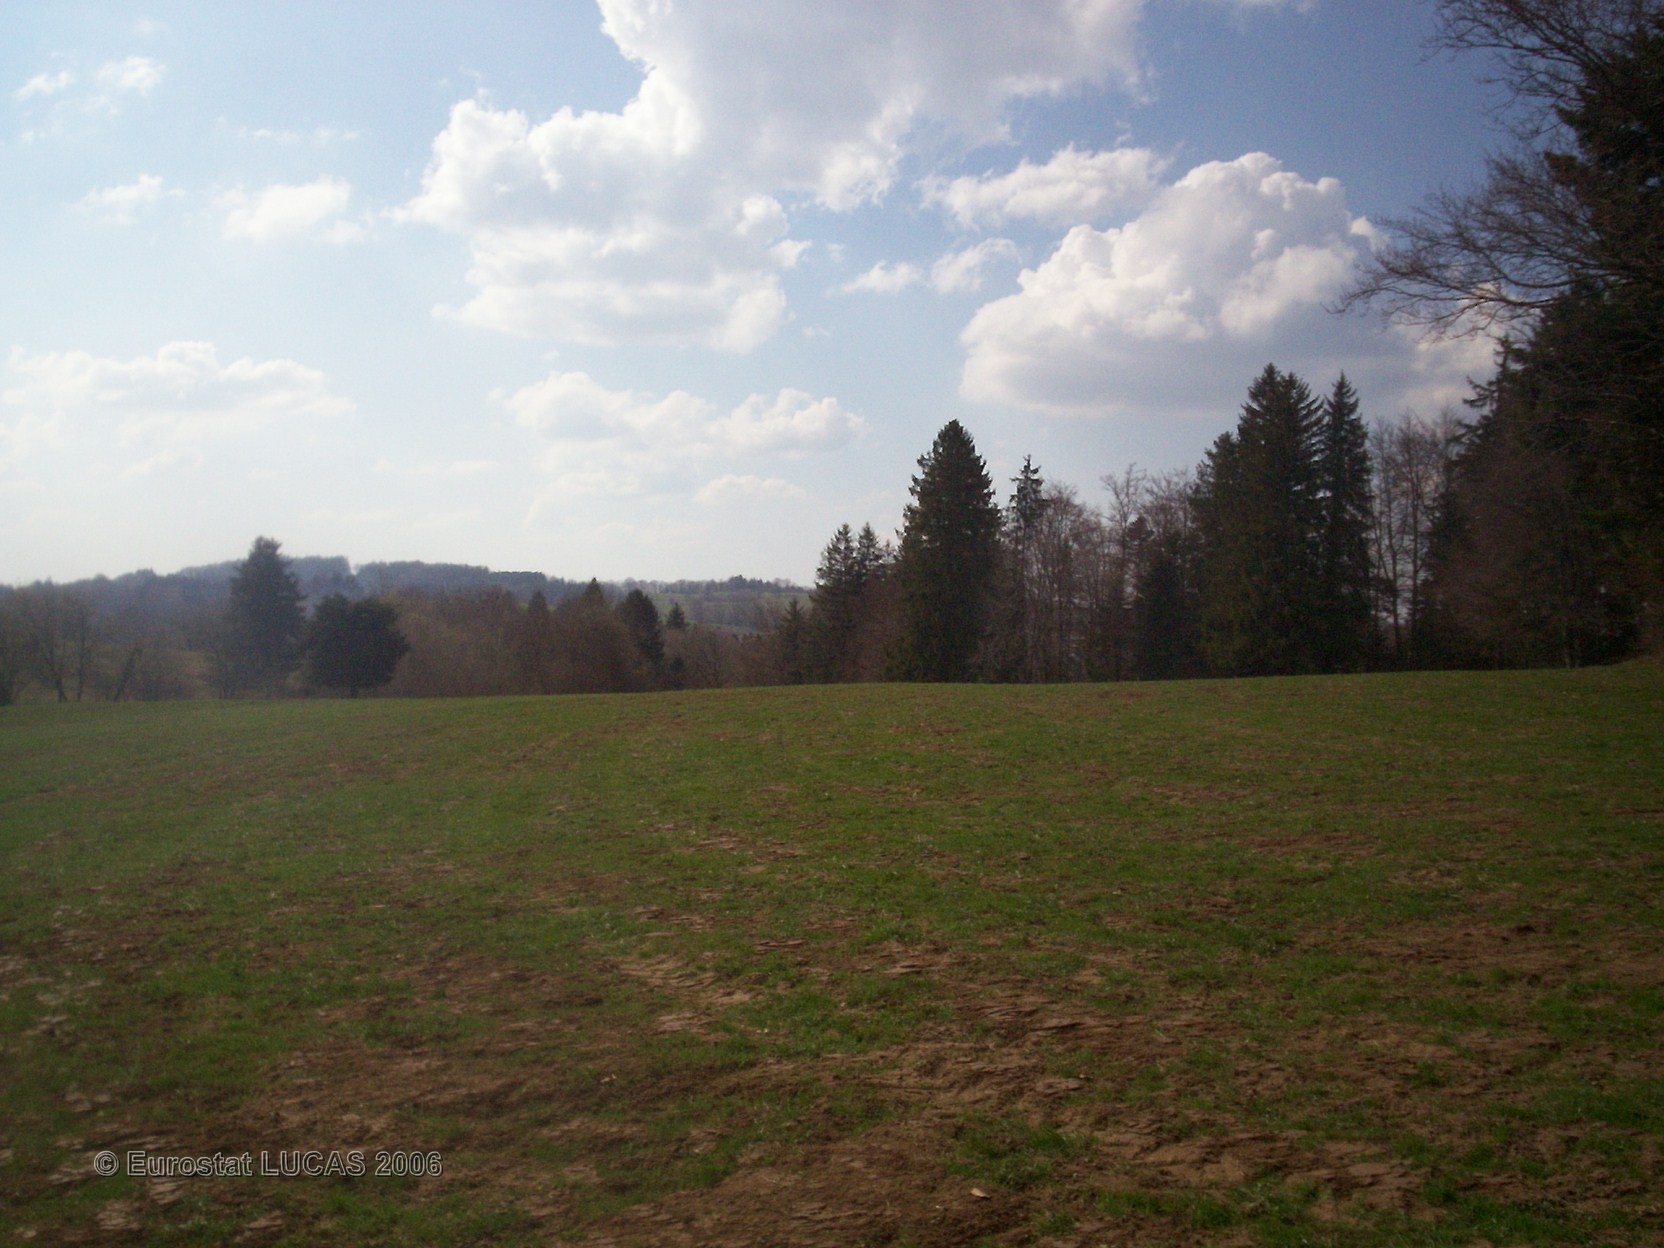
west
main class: Grassland
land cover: Grassland without tree/shrub cover
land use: Agriculture (excluding fallow land and kitchen gardens)
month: April
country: FR
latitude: 47.3160
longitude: 6.9195
